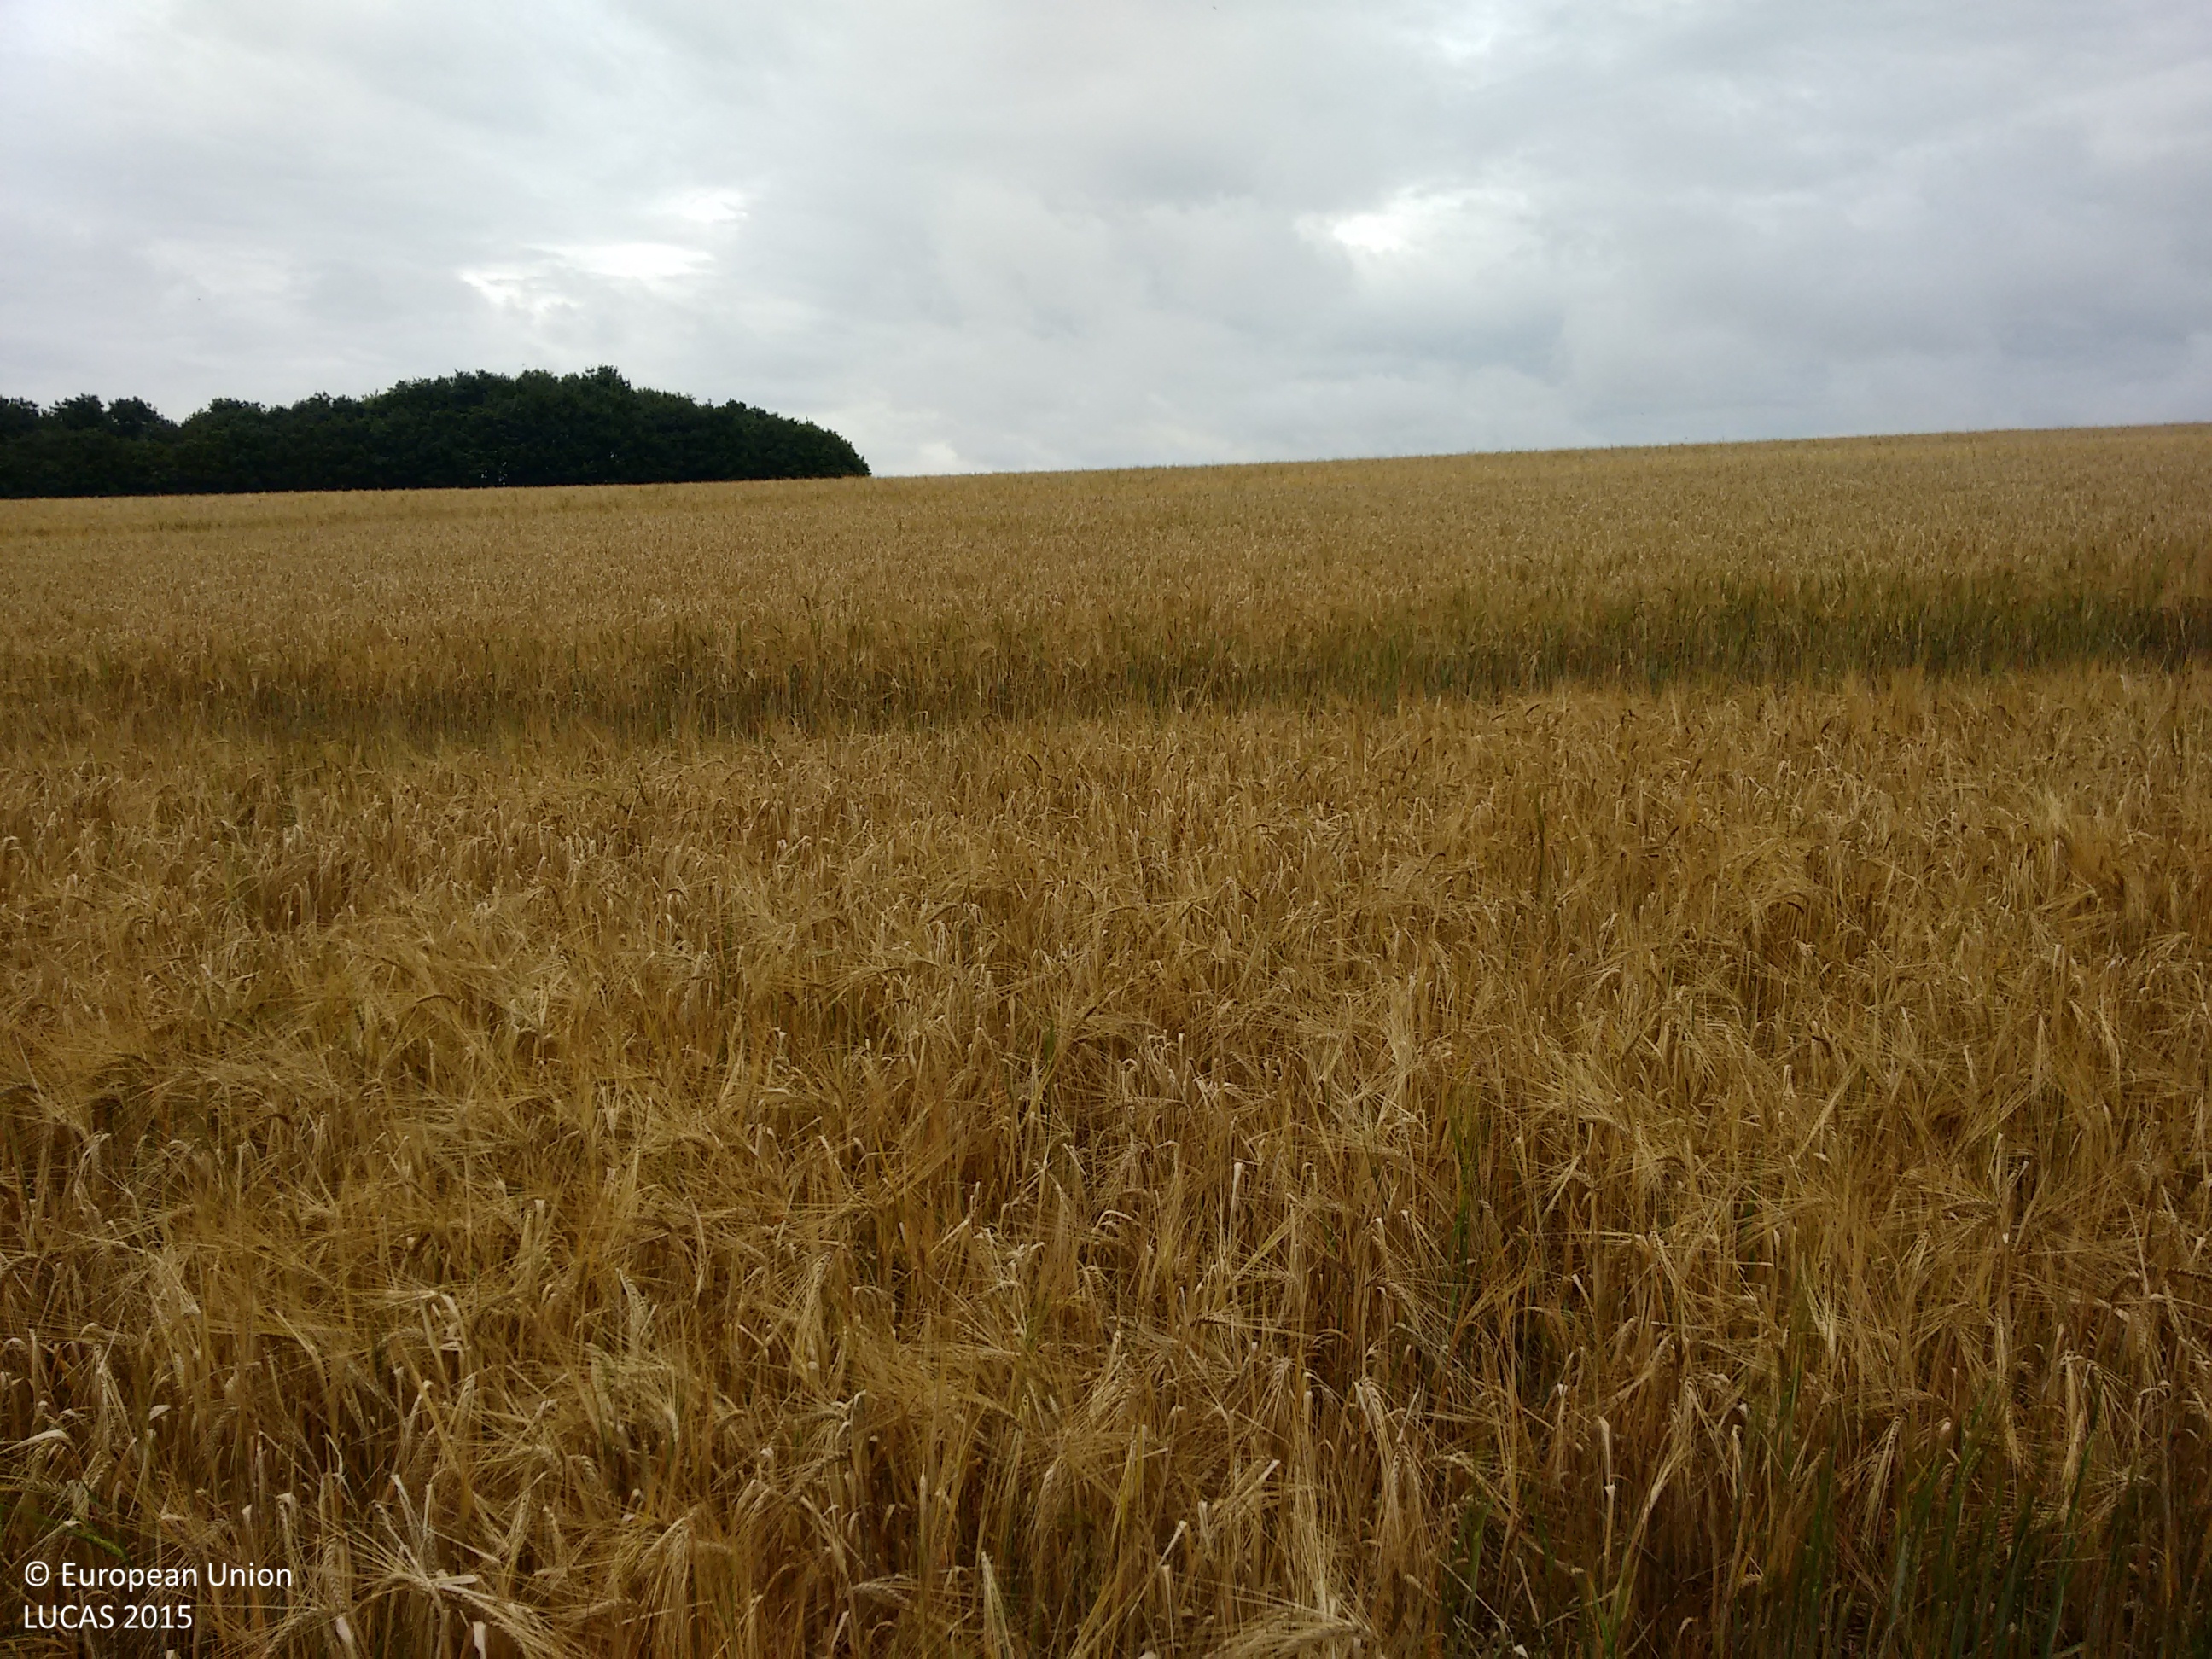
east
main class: Cropland
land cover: Barley
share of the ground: > 75 %
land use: Agriculture (excluding fallow land and kitchen gardens)
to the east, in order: Barley; Tracks; Barley
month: August
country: GB
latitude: 52.0530
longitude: 0.5373
